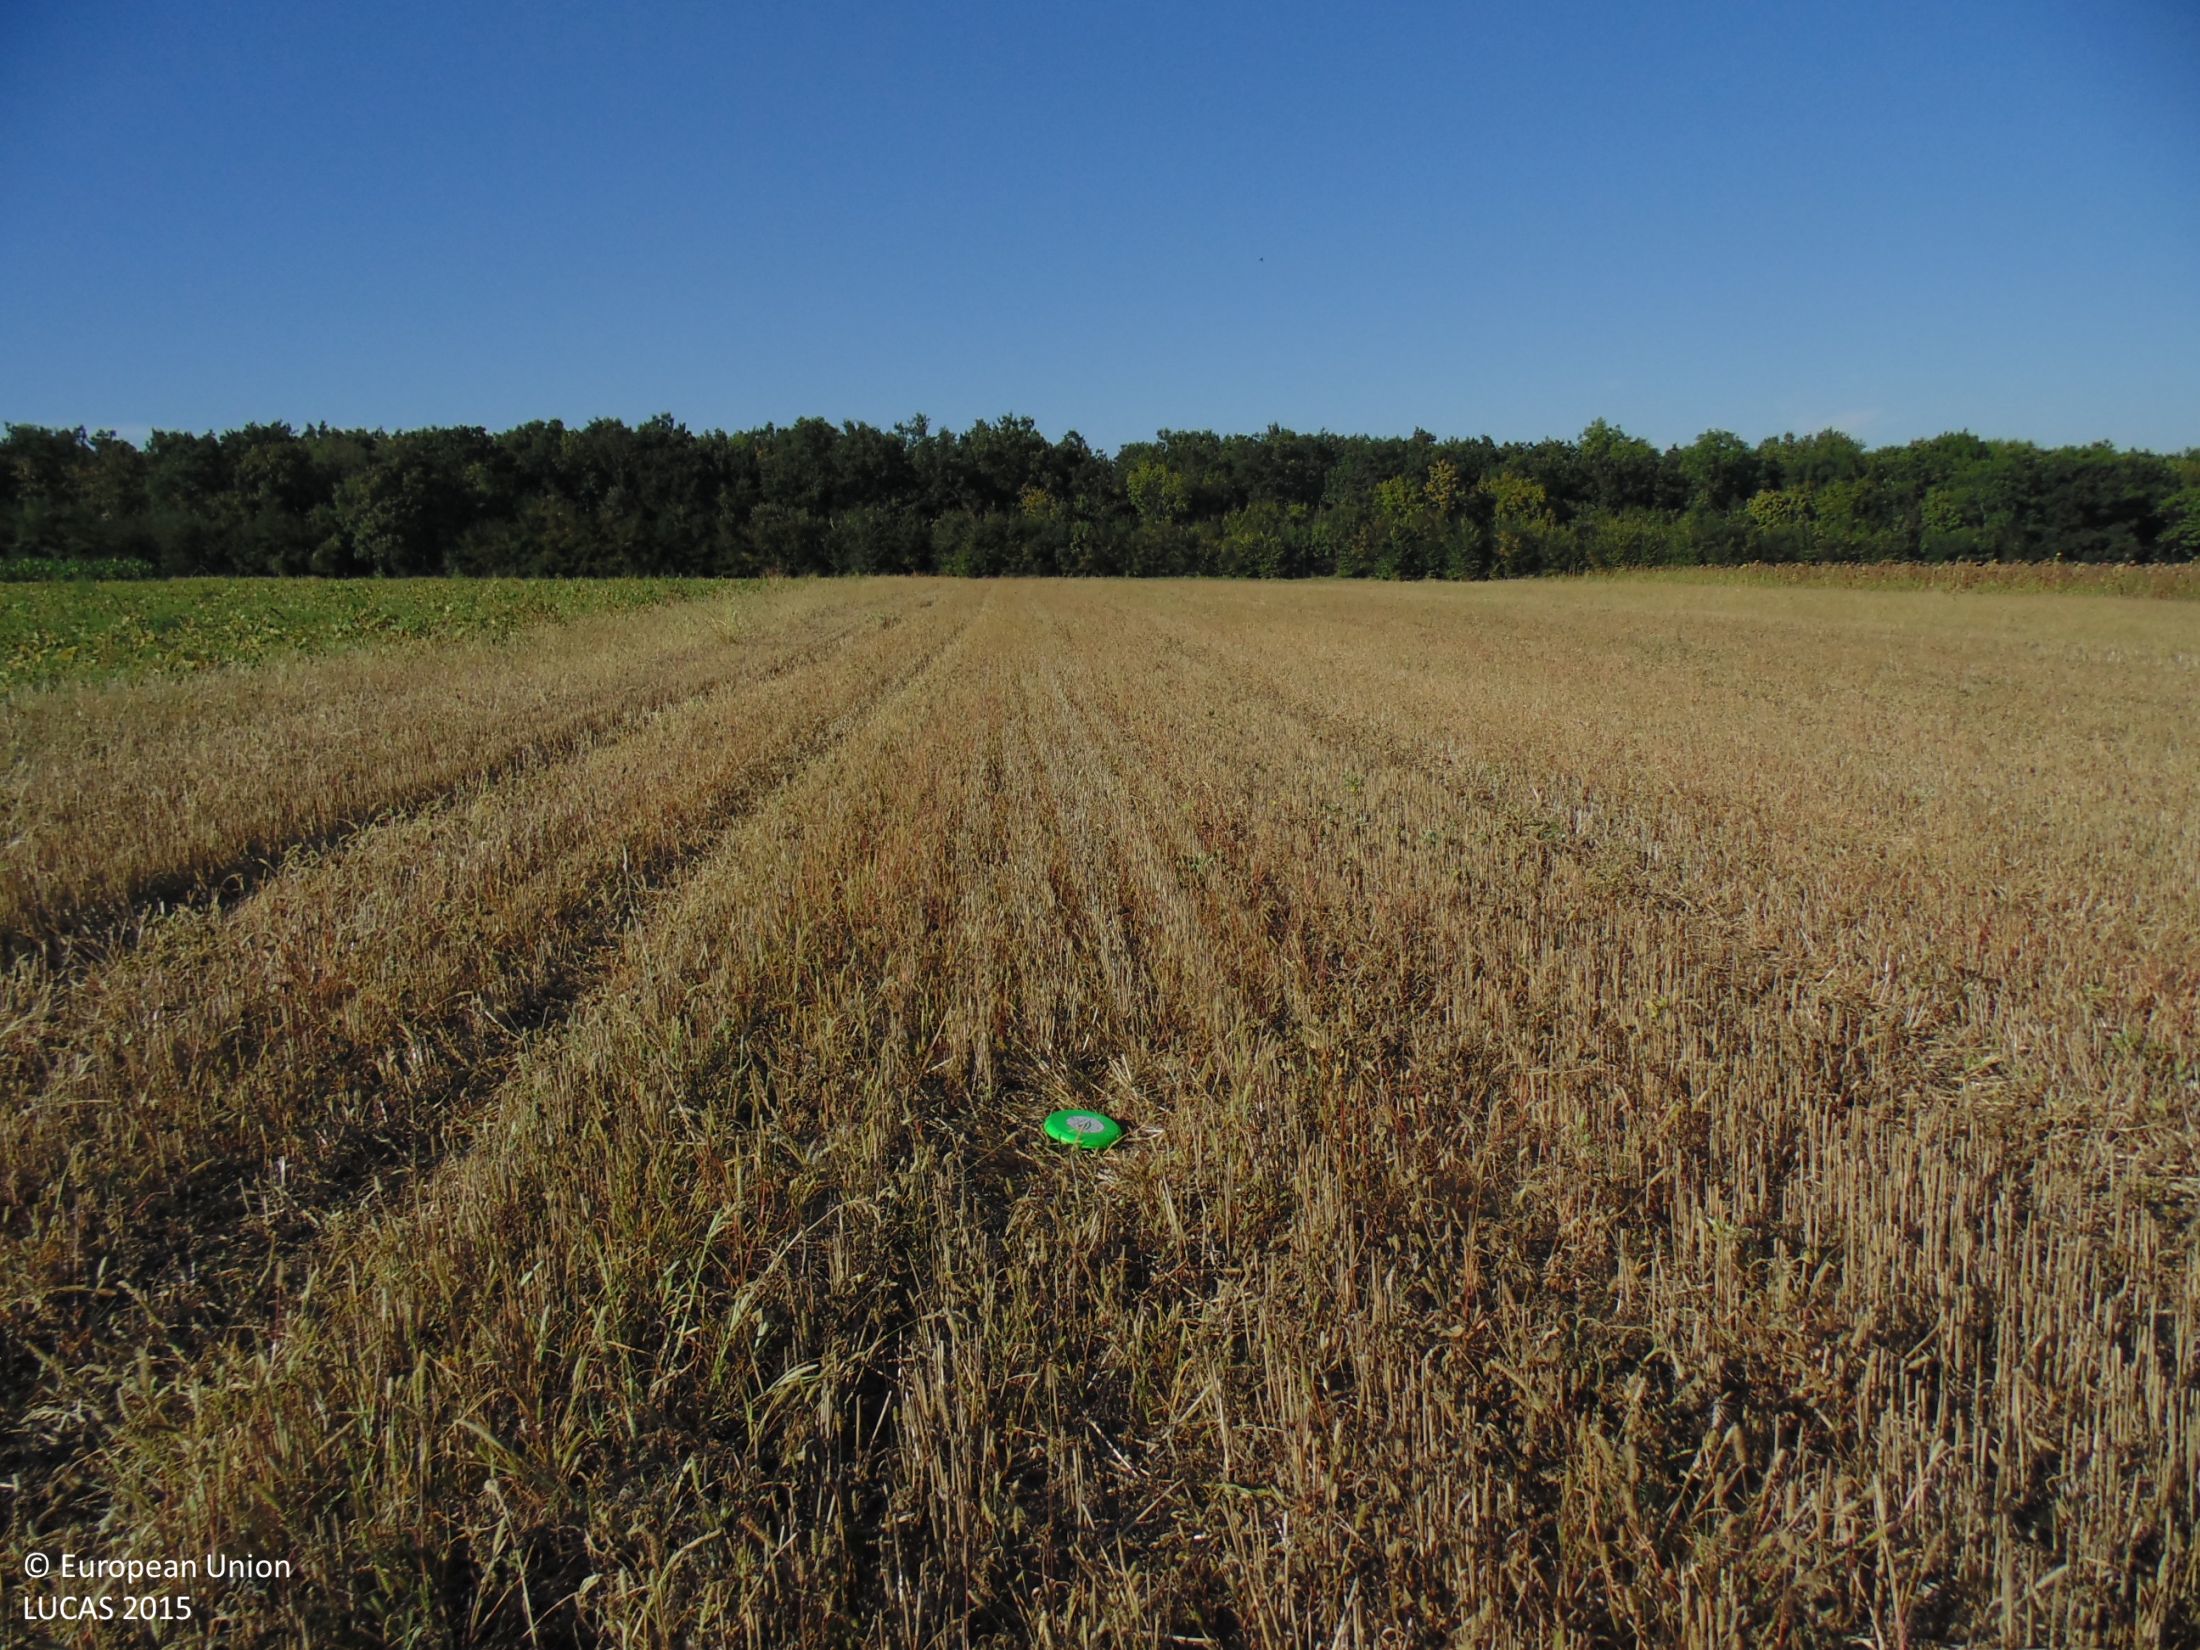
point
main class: Cropland
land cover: Common wheat
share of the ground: 25 - 50 %
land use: Agriculture (excluding fallow land and kitchen gardens)
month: September
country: BG
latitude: 43.8588
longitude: 26.9792
